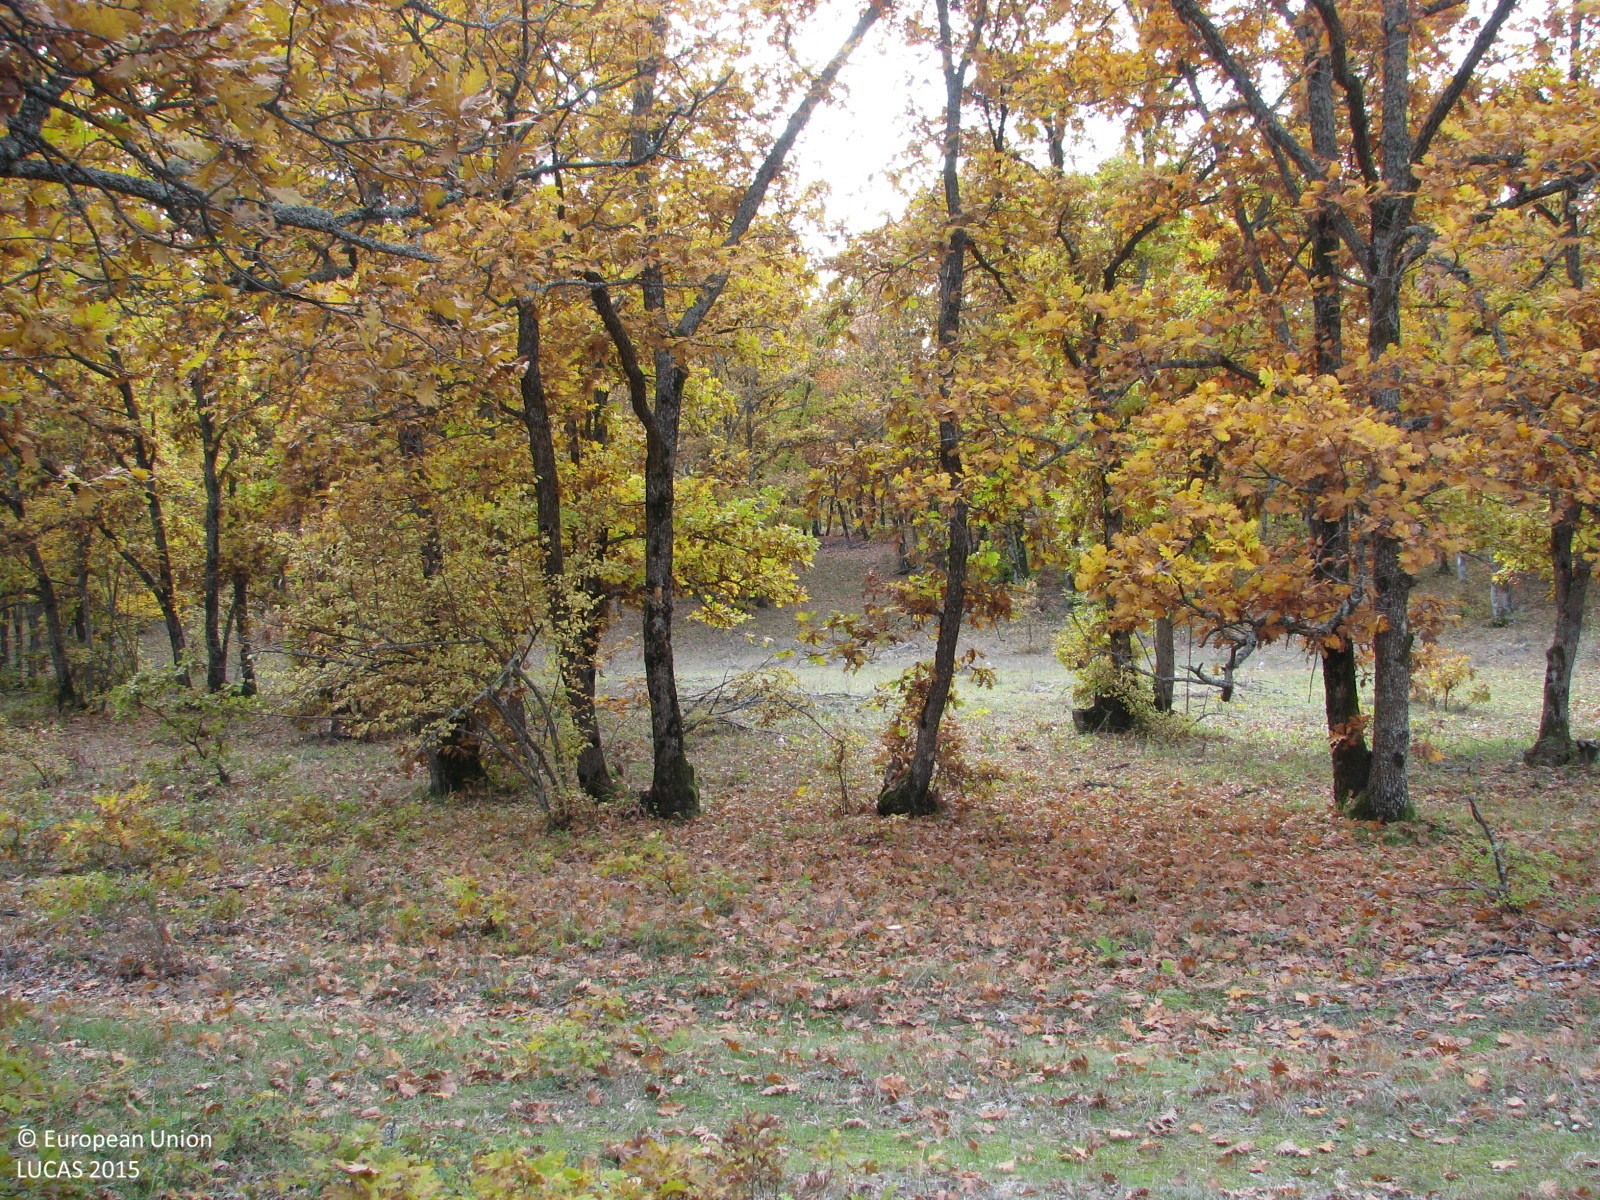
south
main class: Woodland
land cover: Broadleaved woodland
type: thermophilous deciduous forest
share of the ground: 50 - 75 %
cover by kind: broadleaved forest trees 55 %, herbaceous plants 40 %, shrubs 5 %
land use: Forestry
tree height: > 5 m
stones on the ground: < 10 %
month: November
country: BG
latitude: 41.9847
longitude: 26.4141
